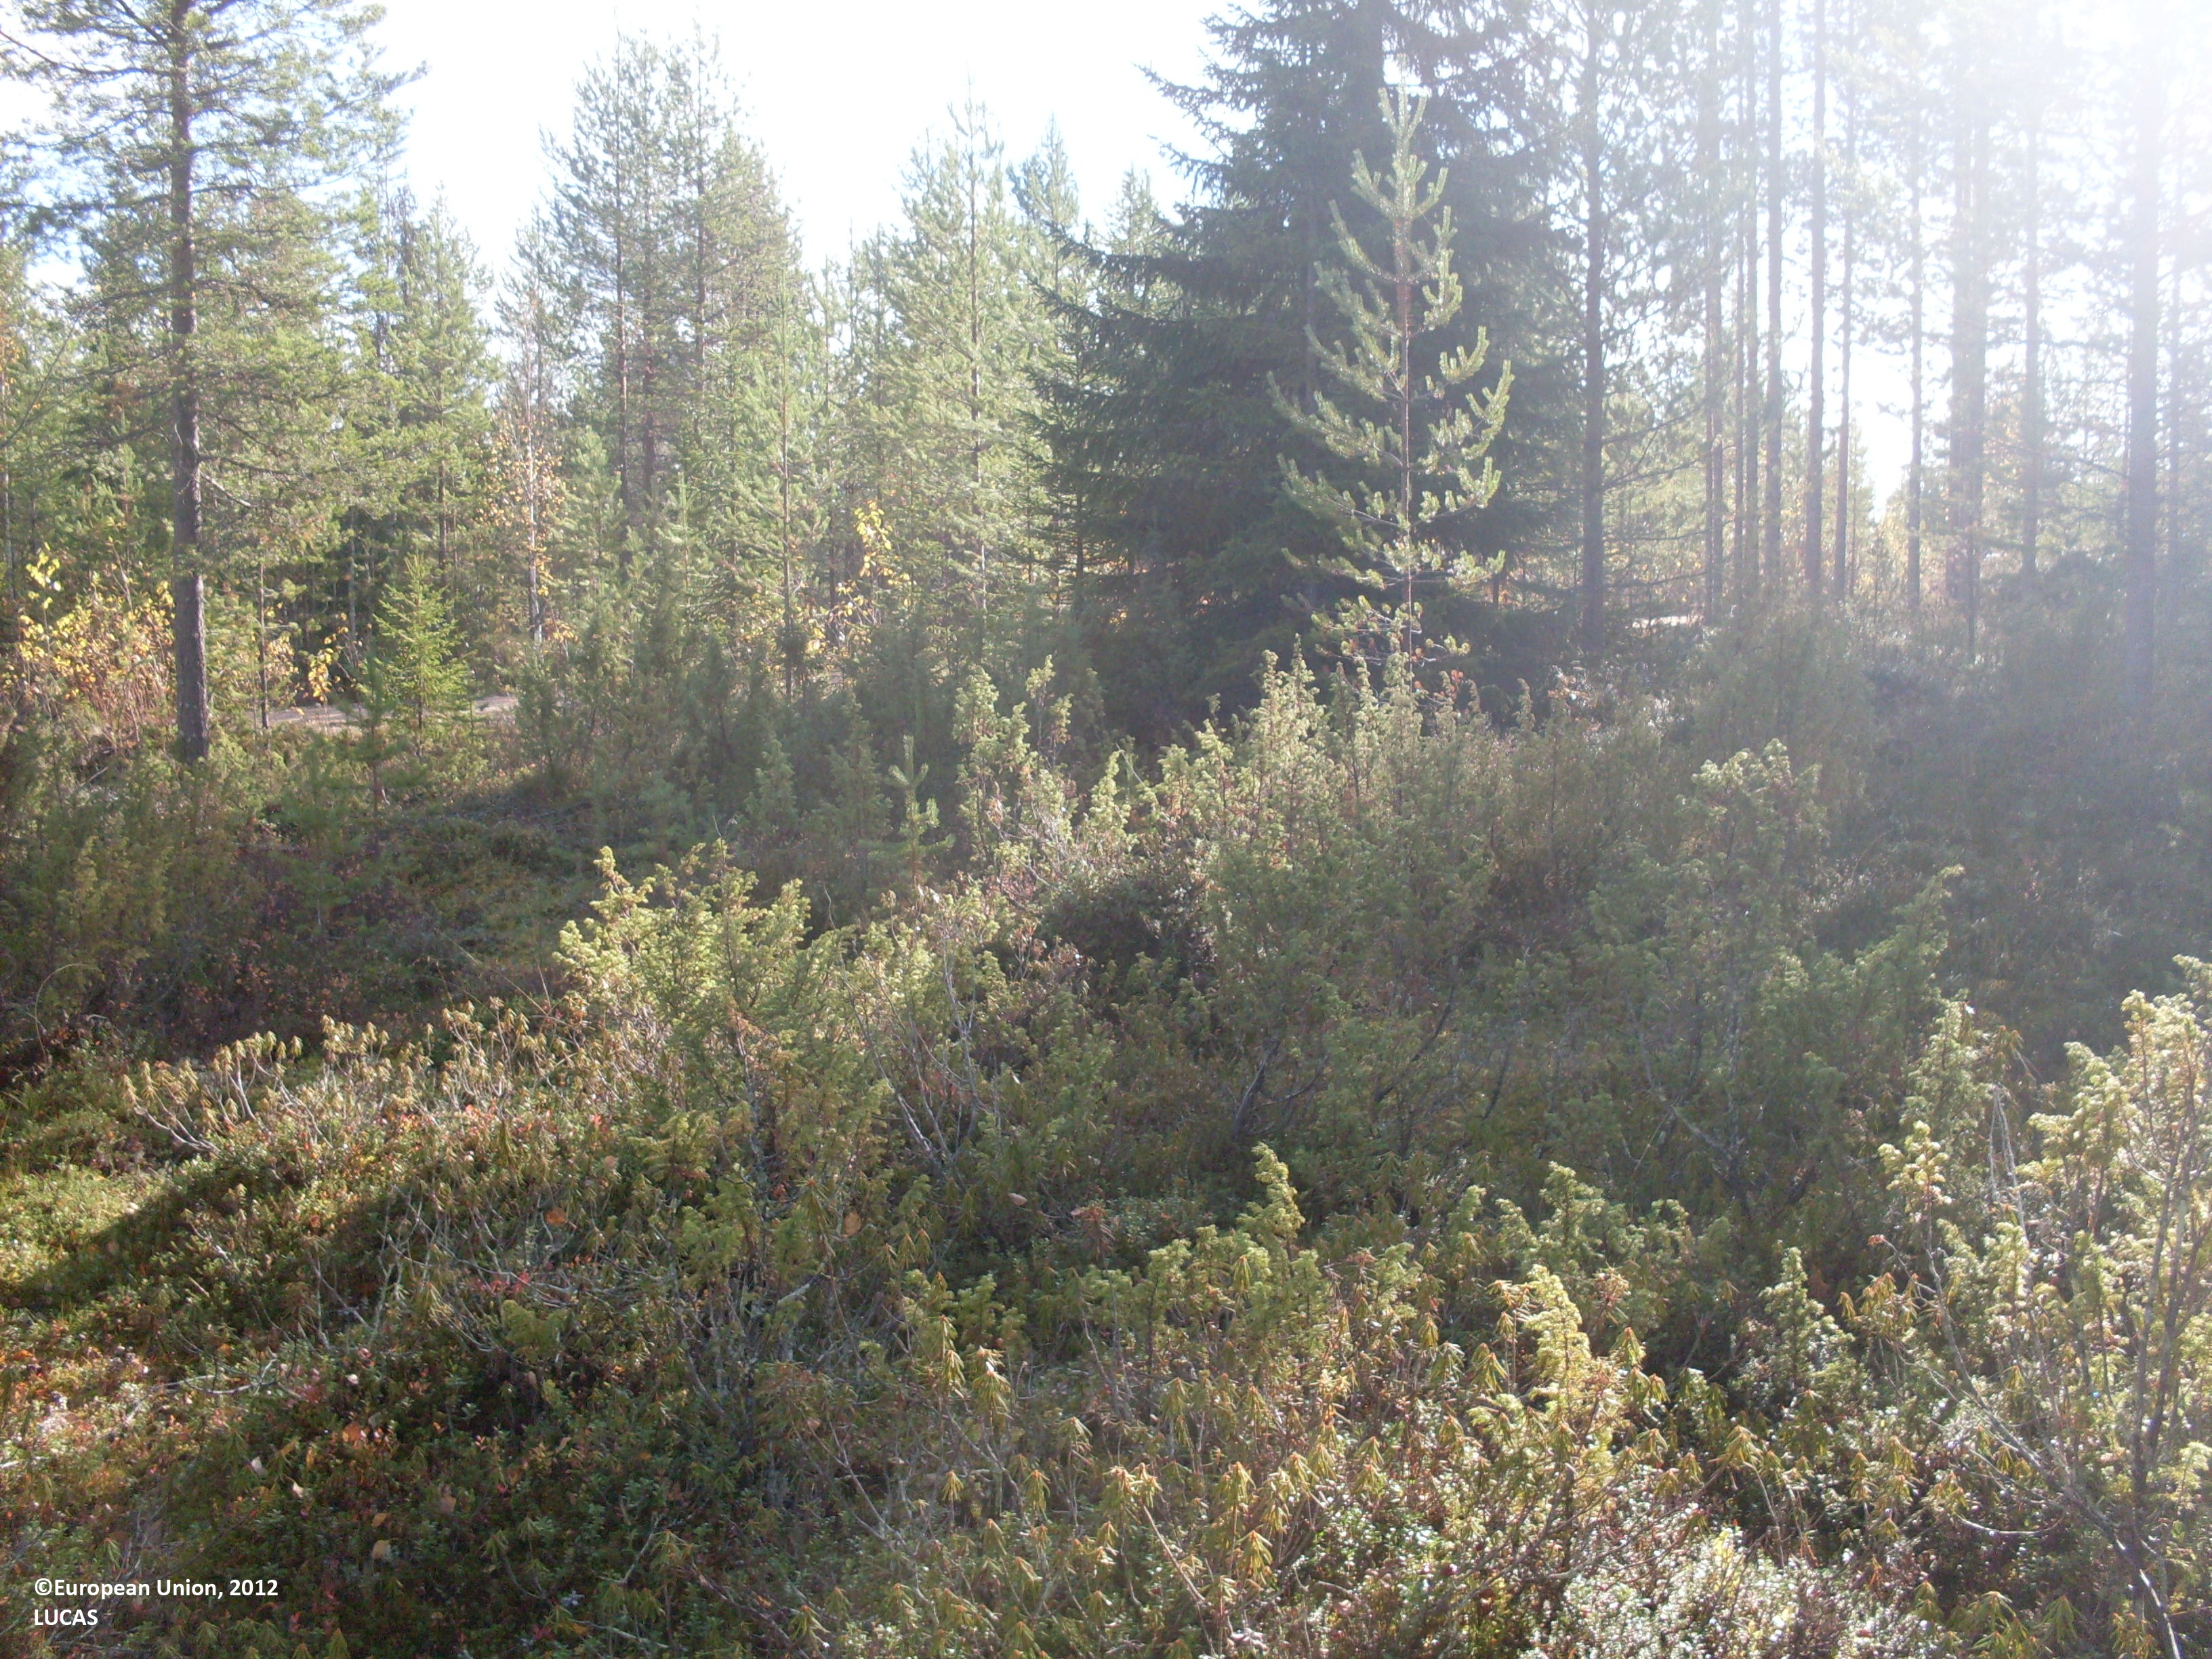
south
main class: Woodland
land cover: Pine dominated mixed woodland
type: boreal forest
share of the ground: 10 - 25 %
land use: Forestry
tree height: > 5 m
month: September
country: FI
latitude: 64.7512
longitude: 29.4326
